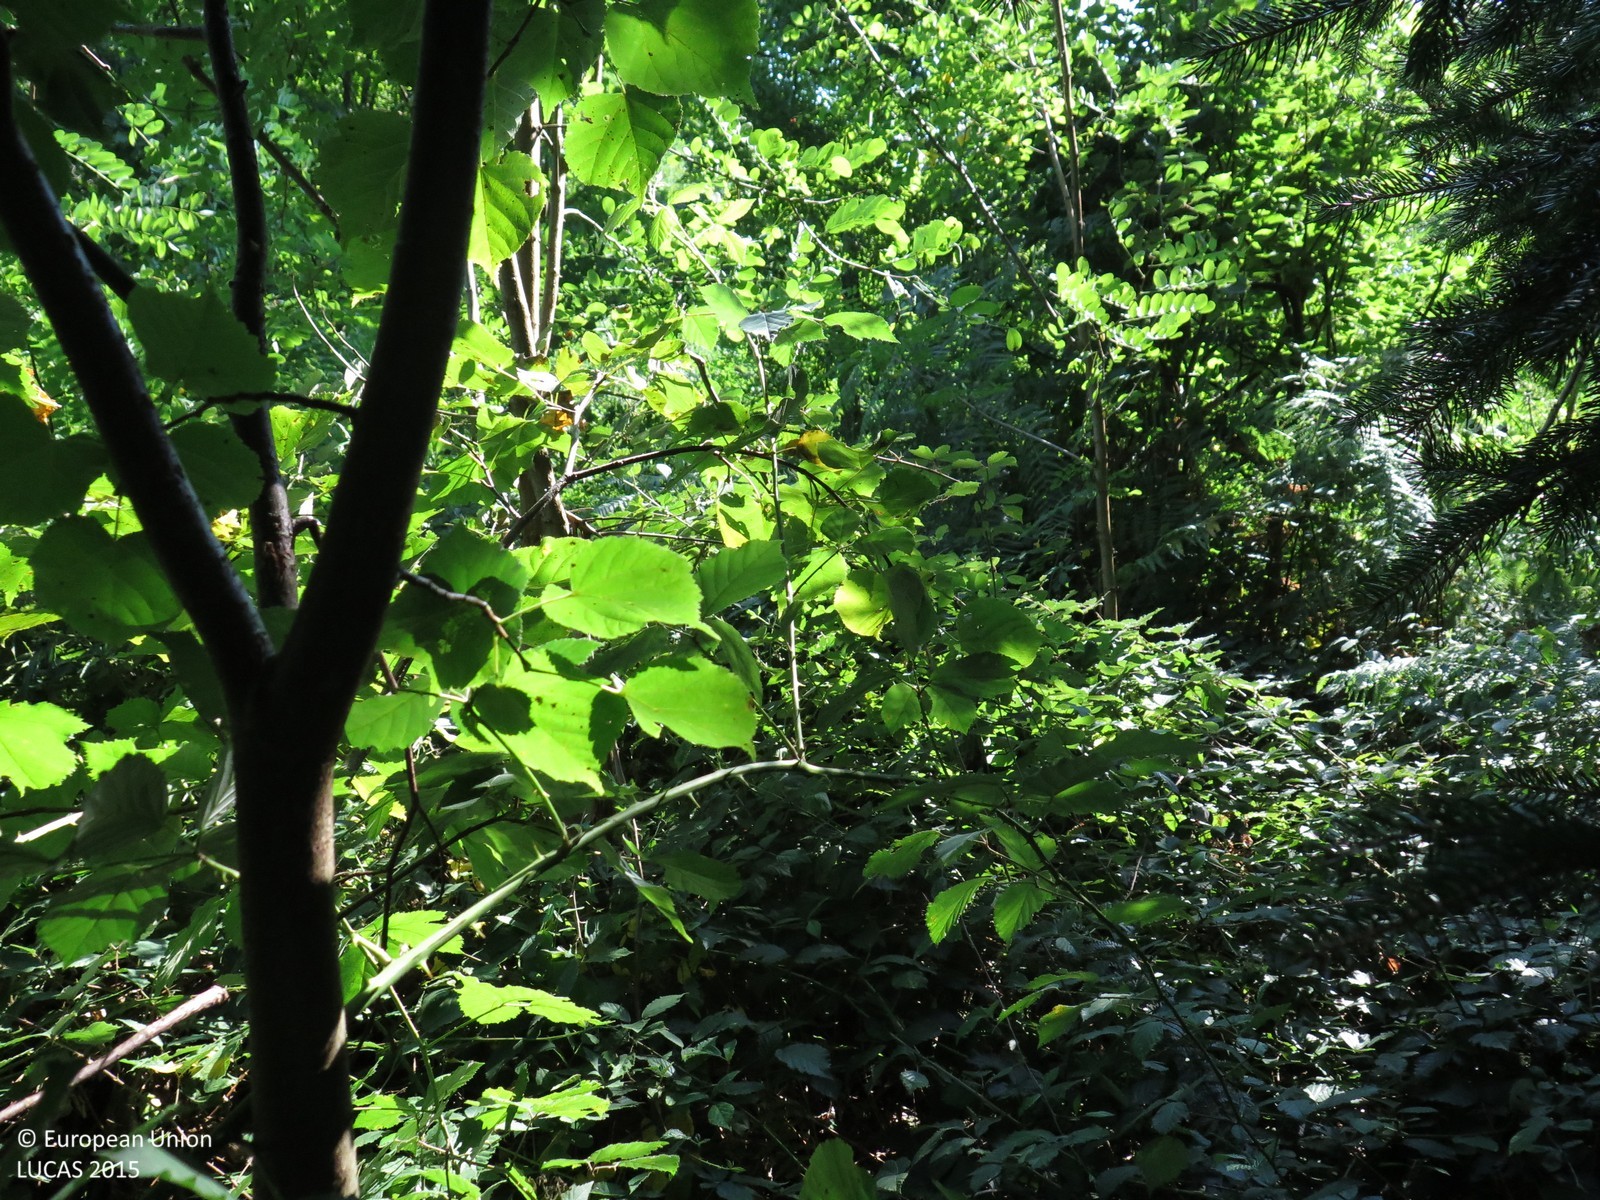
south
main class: Woodland
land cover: Other mixed woodland
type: mountainous beech forest
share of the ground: > 75 %
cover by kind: coniferous forest trees 75 %, broadleaved forest trees 25 %
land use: Forestry
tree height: > 5 m
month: August
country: HR
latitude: 45.3934
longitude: 15.2200
